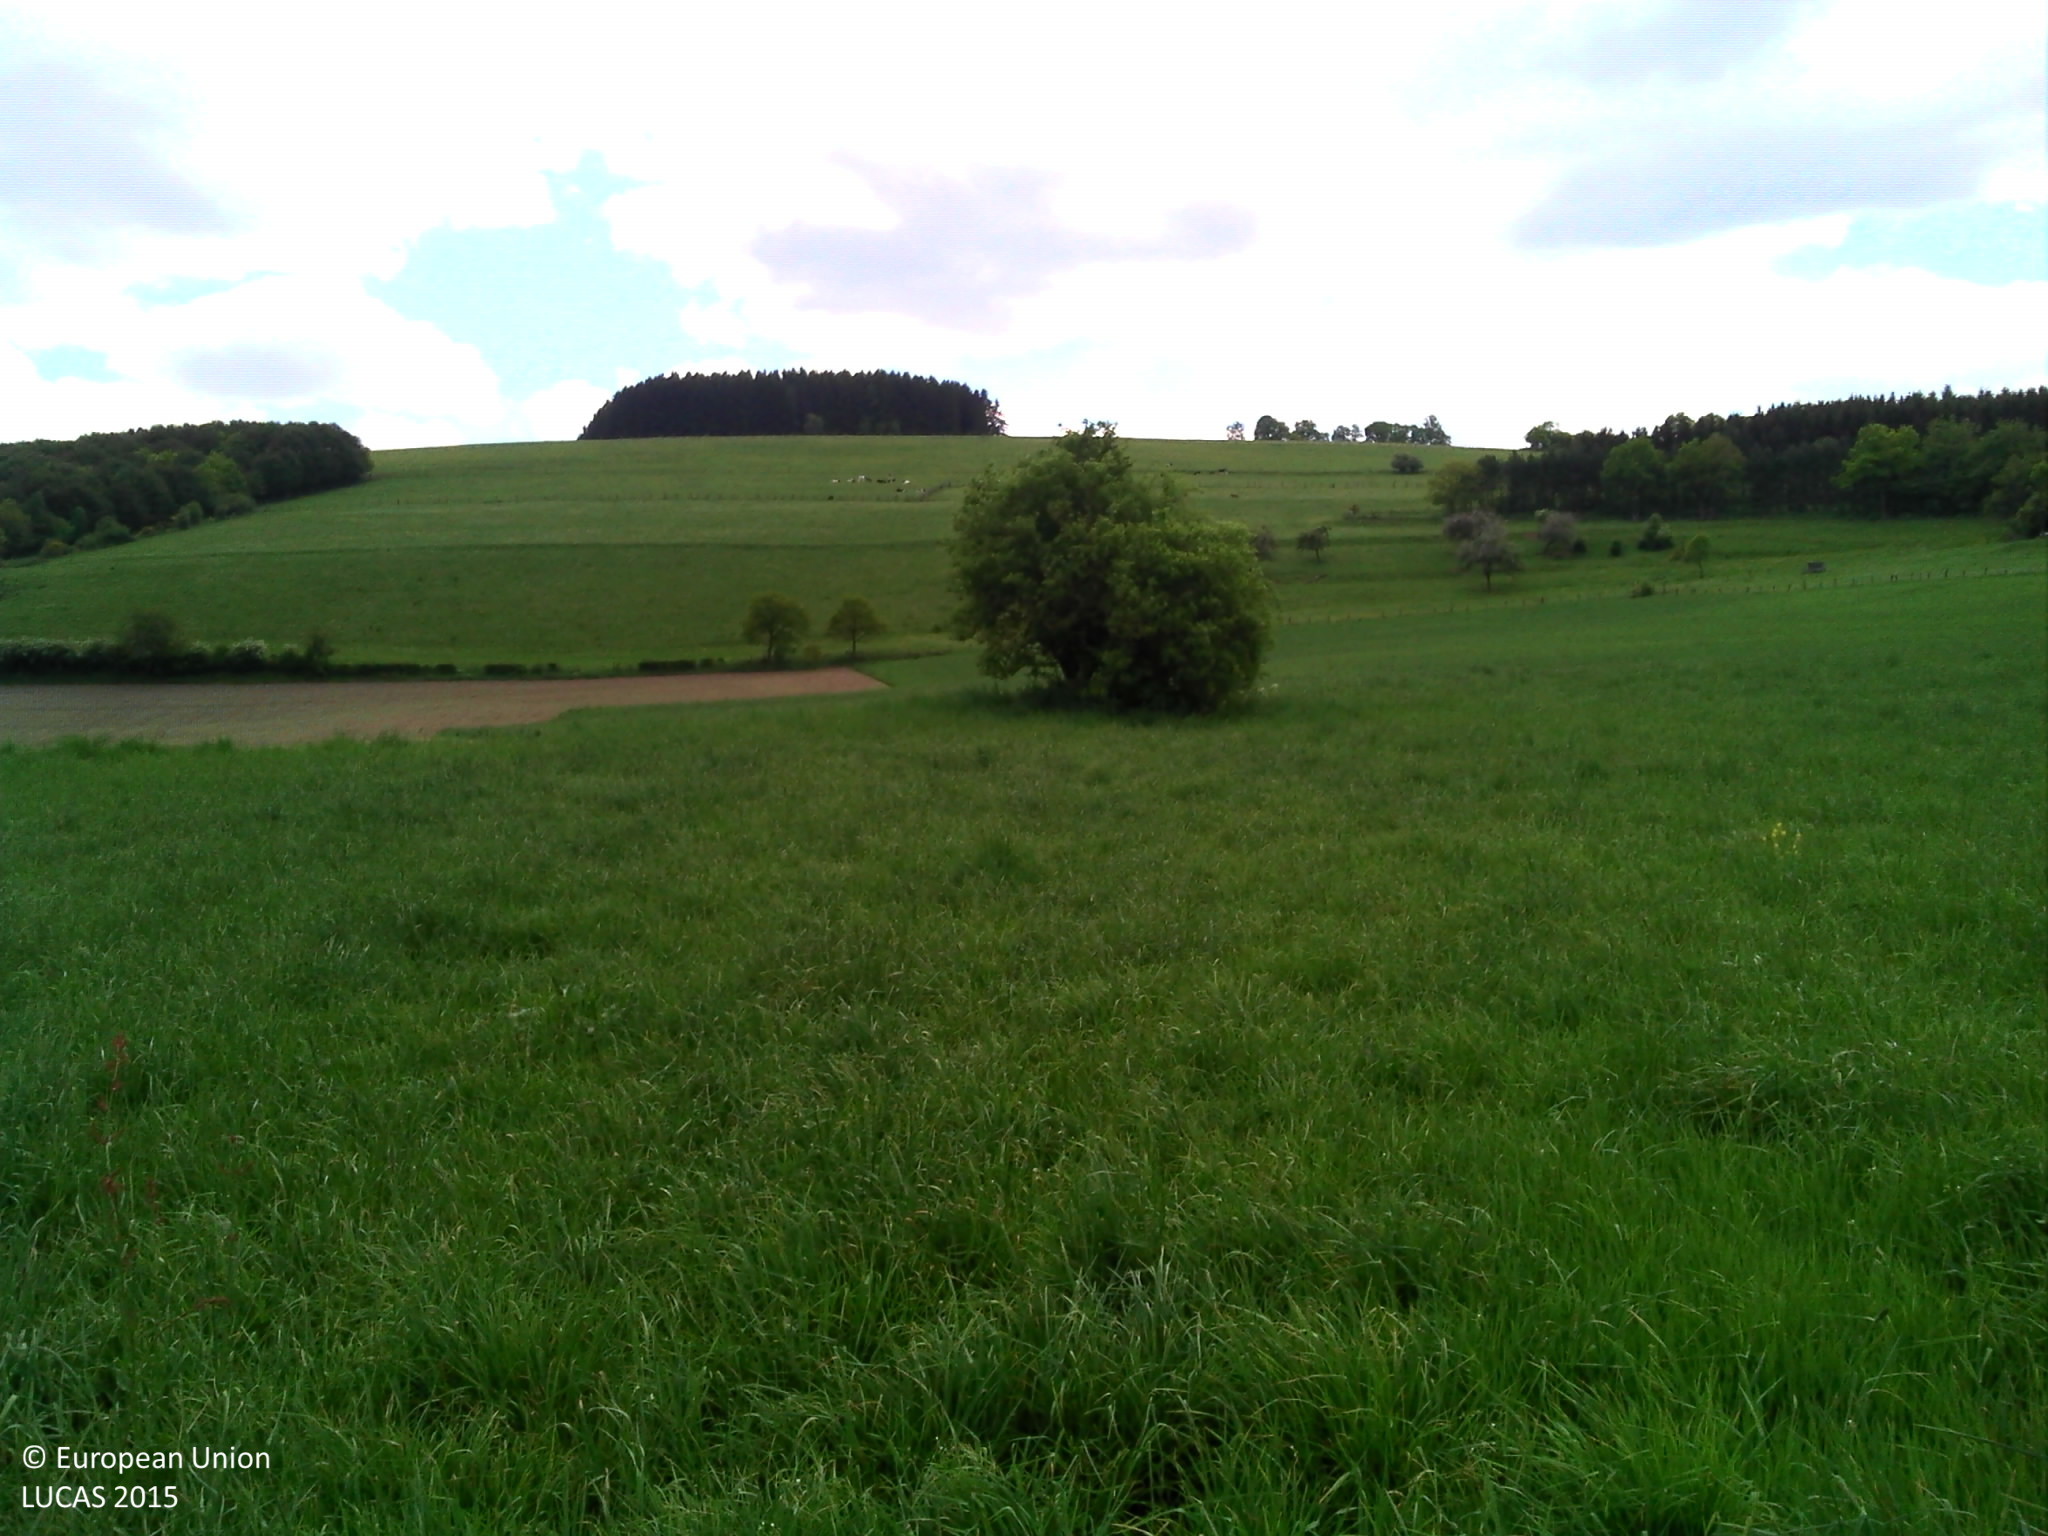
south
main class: Grassland
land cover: Grassland without tree/shrub cover
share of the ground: > 75 %
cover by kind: herbaceous plants 100 %
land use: Agriculture (excluding fallow land and kitchen gardens)
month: May
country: LU
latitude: 49.9660
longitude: 5.8863
